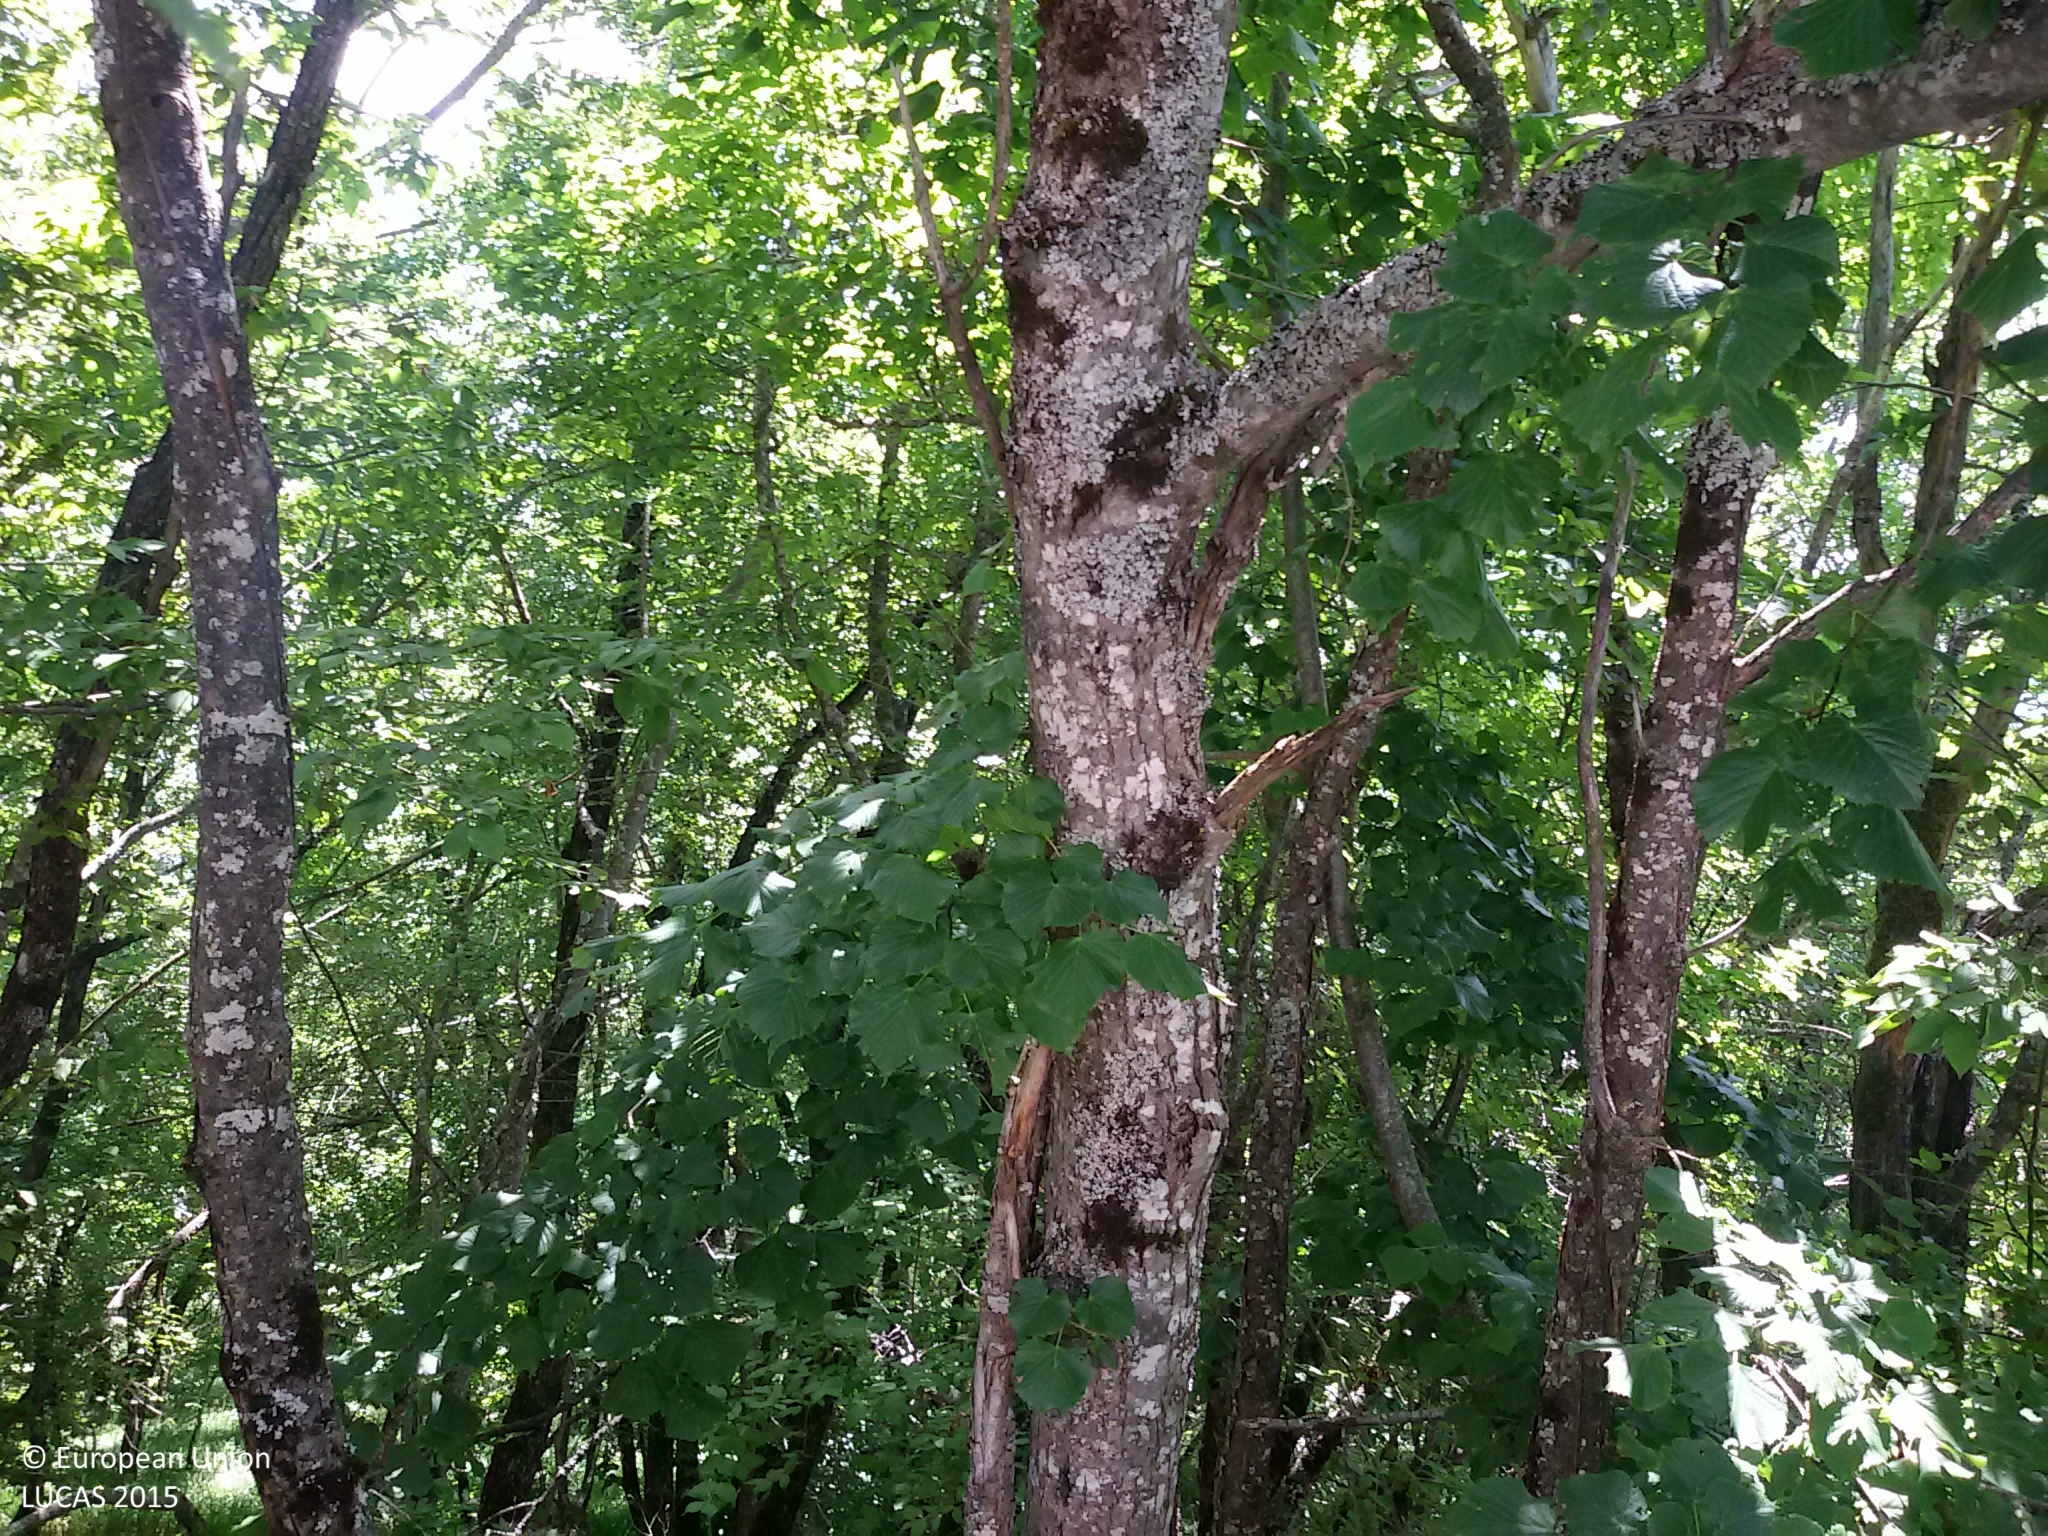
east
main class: Woodland
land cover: Broadleaved woodland
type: mountainous beech forest
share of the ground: 50 - 75 %
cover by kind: broadleaved forest trees 50 %, consolidated bare surface 20 %, shrubs 10 %, lichens and mosses 10 %, herbaceous plants 5 %, unconsolidated bare surface 5 %
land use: Semi-natural and natural areas not in use
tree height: > 5 m
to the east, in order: Broadleaved woodland; Tracks; Broadleaved woodland
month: June
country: HR
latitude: 44.5610
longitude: 15.5962
